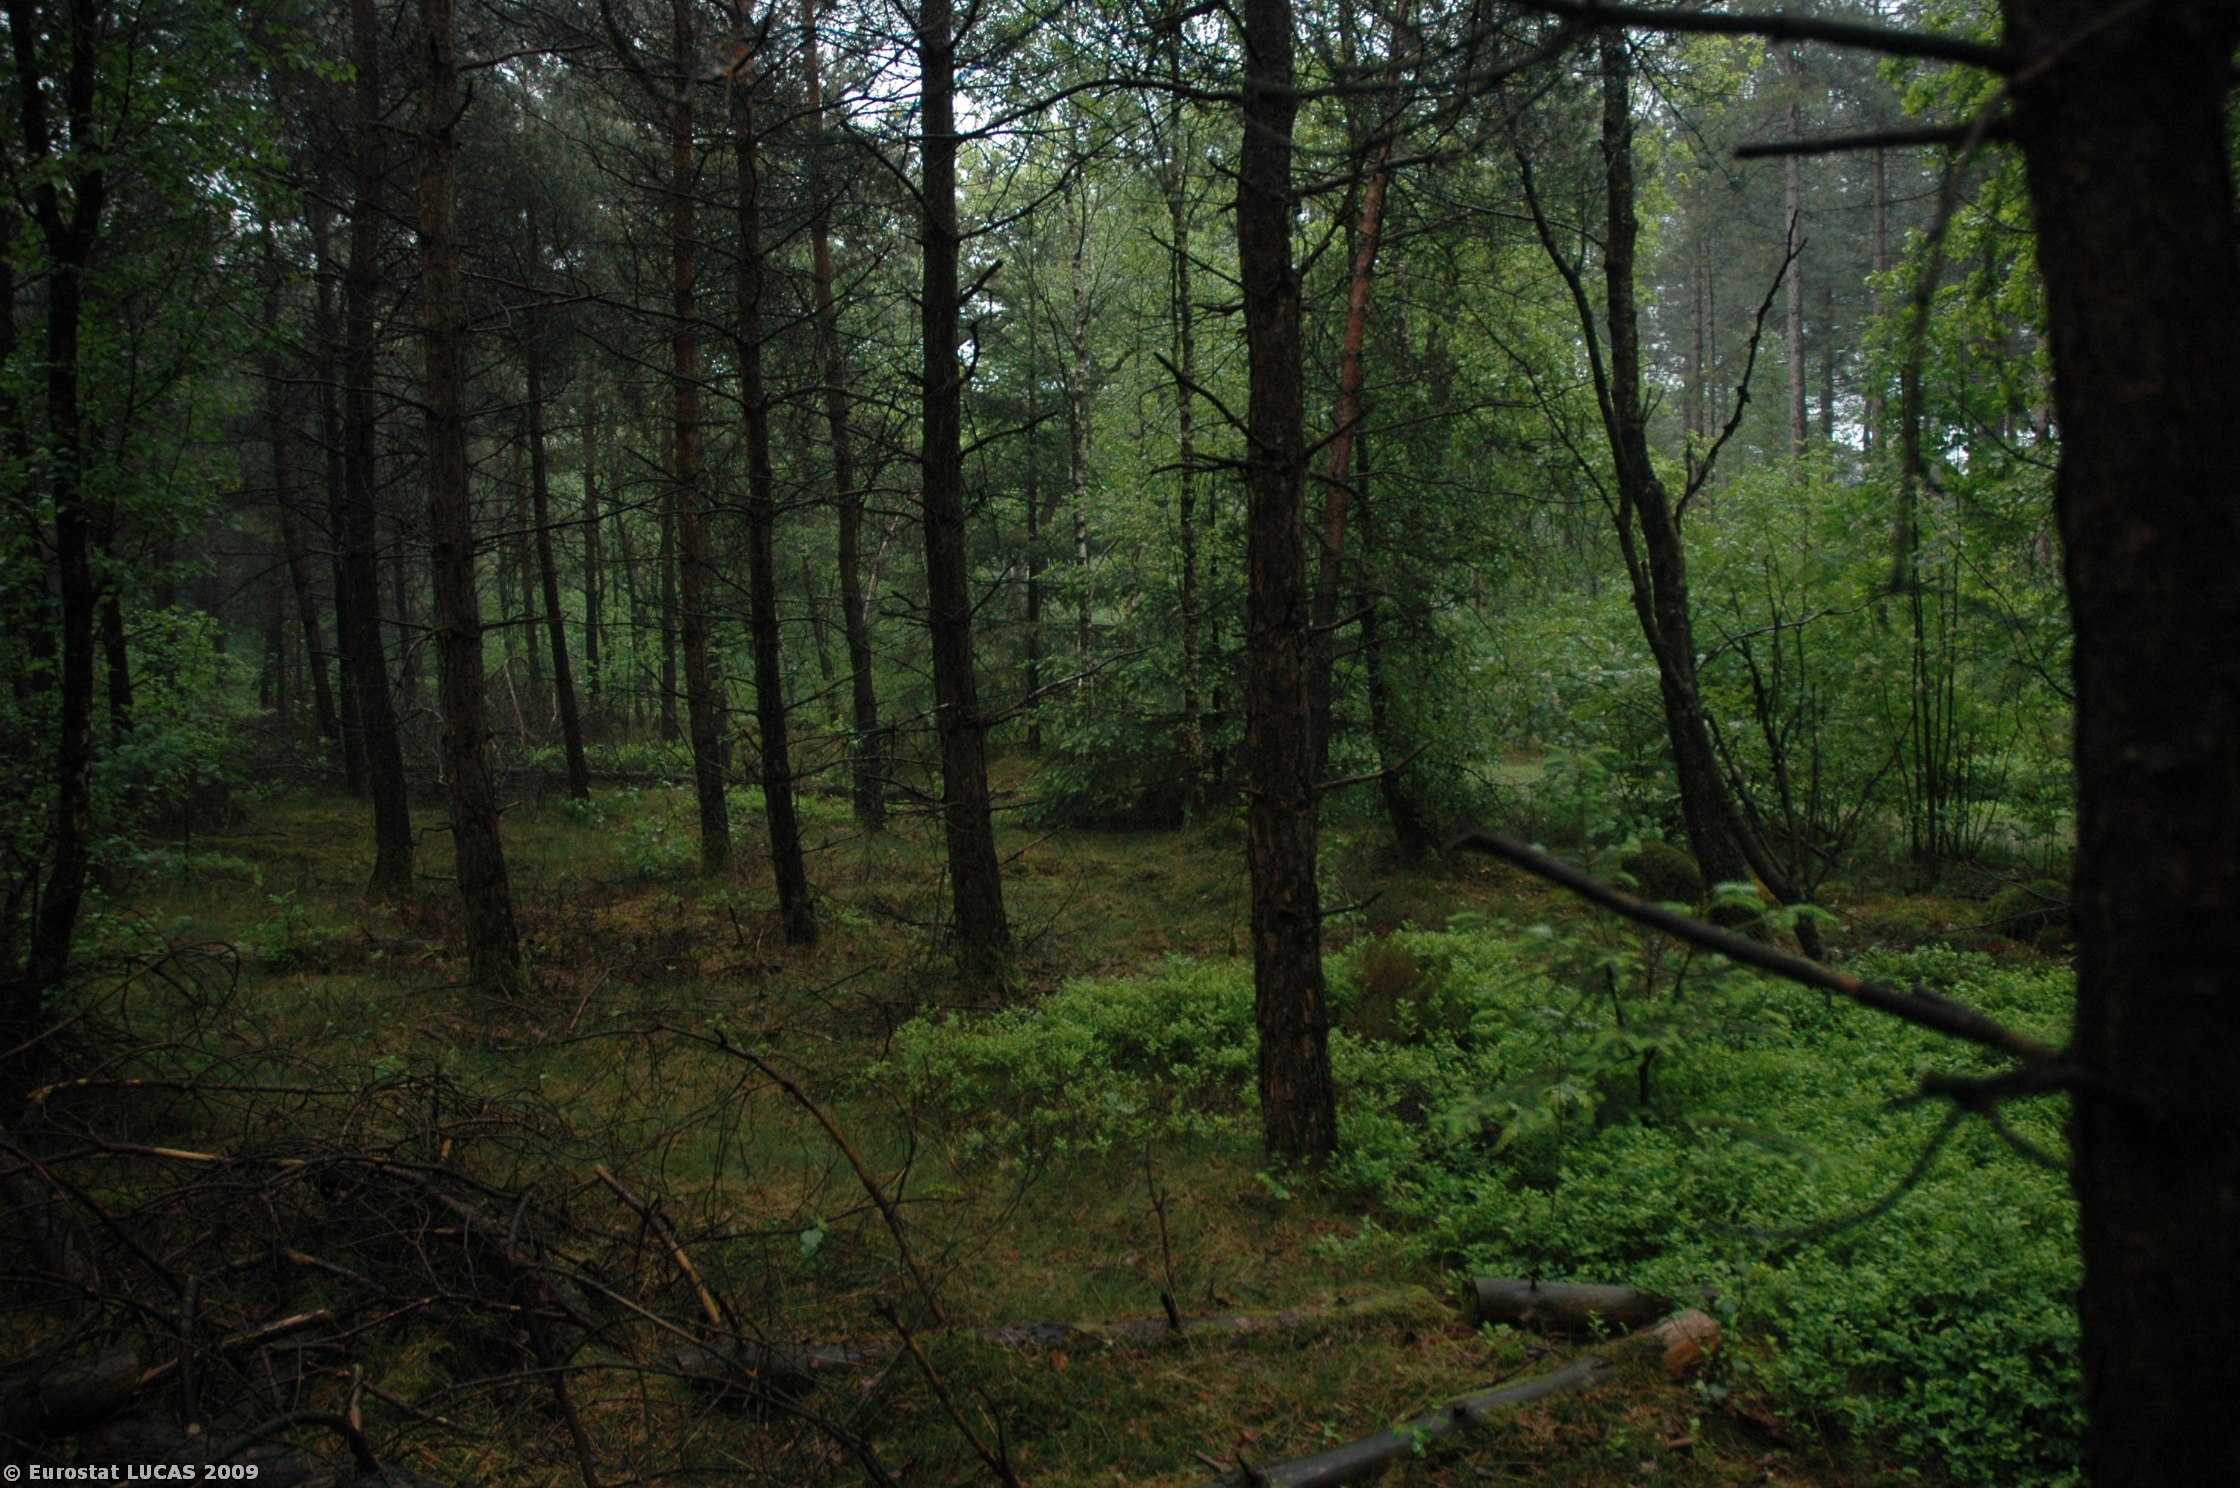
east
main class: Woodland
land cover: Mixed woodland
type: hemiboreal forest and nemoral coniferous forest and mixed broadleaved-coniferous forest
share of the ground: > 75 %
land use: Amenities, museums, leisure
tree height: > 5 m
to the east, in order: Mixed woodland; Tracks; Mixed woodland; Tracks; Mixed woodland; Tracks; Mixed woodland
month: May
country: NL
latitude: 52.1049
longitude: 5.3113
